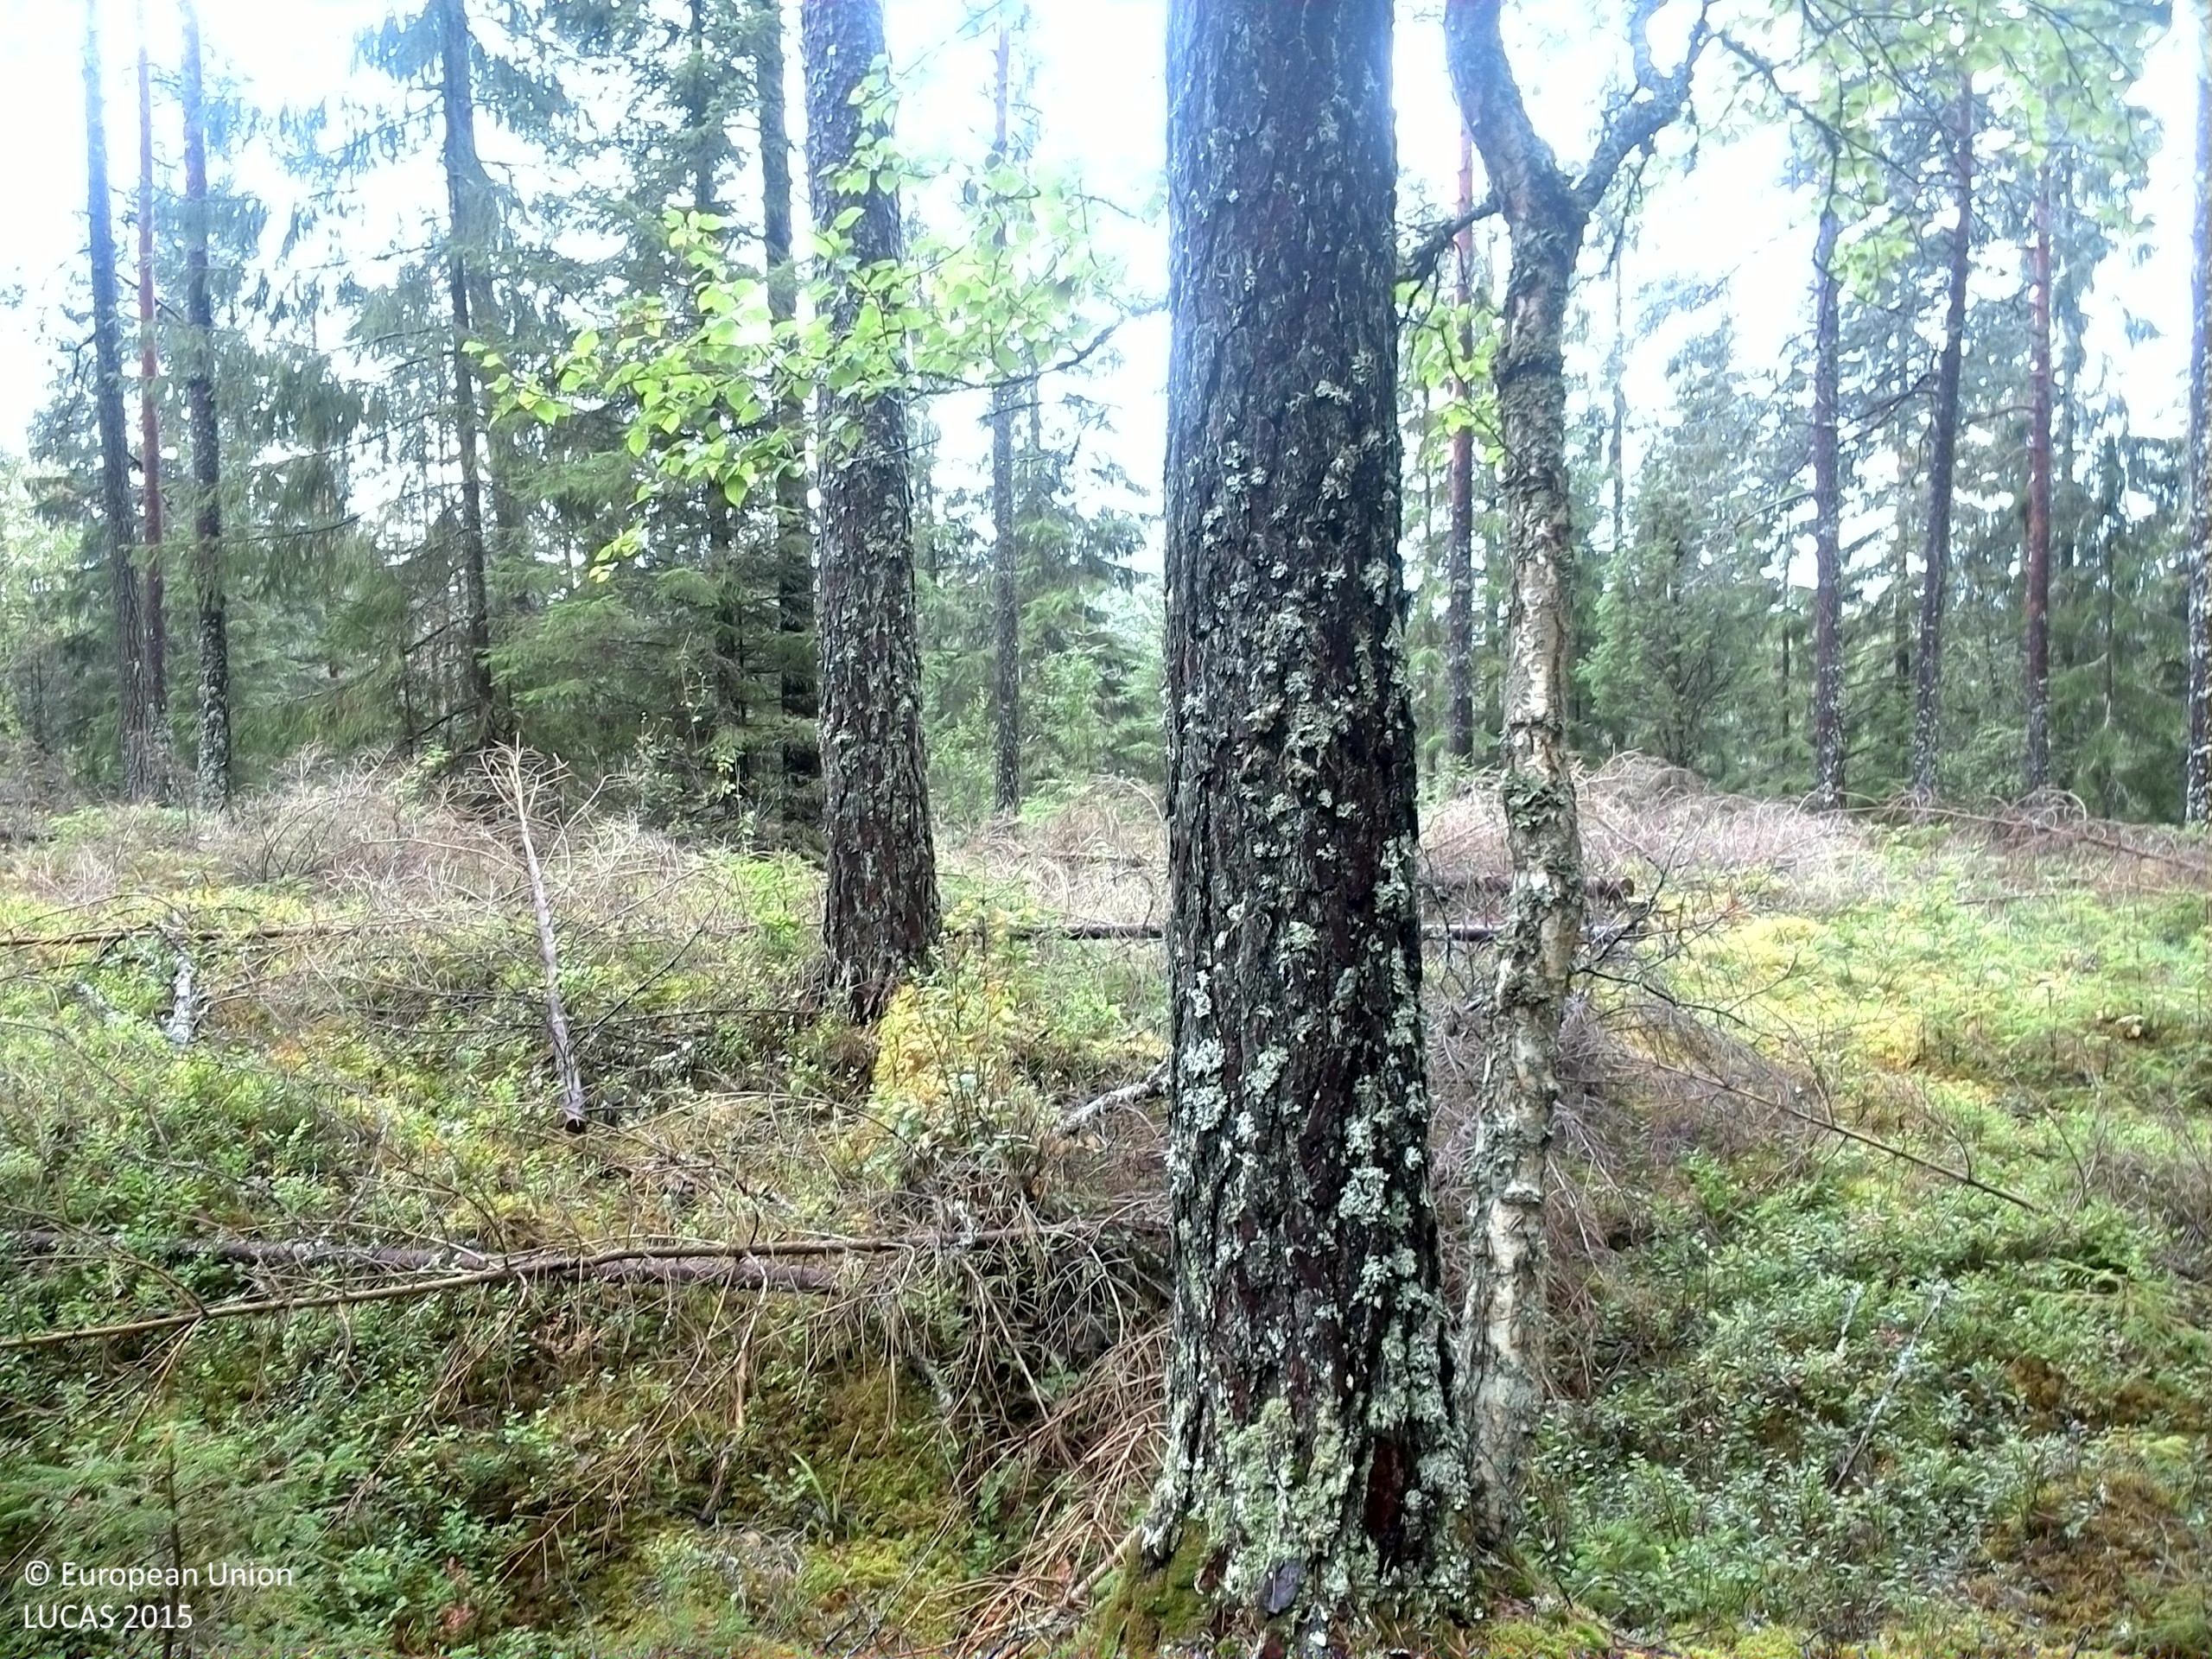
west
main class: Woodland
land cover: Pine dominated coniferous woodland
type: boreal forest
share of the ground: 50 - 75 %
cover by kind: coniferous forest trees 65 %, lichens and mosses 20 %, shrubs 10 %, broadleaved forest trees 5 %
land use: Forestry
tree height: > 5 m
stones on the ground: < 10 %
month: September
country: SE
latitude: 59.2656
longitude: 12.0474
